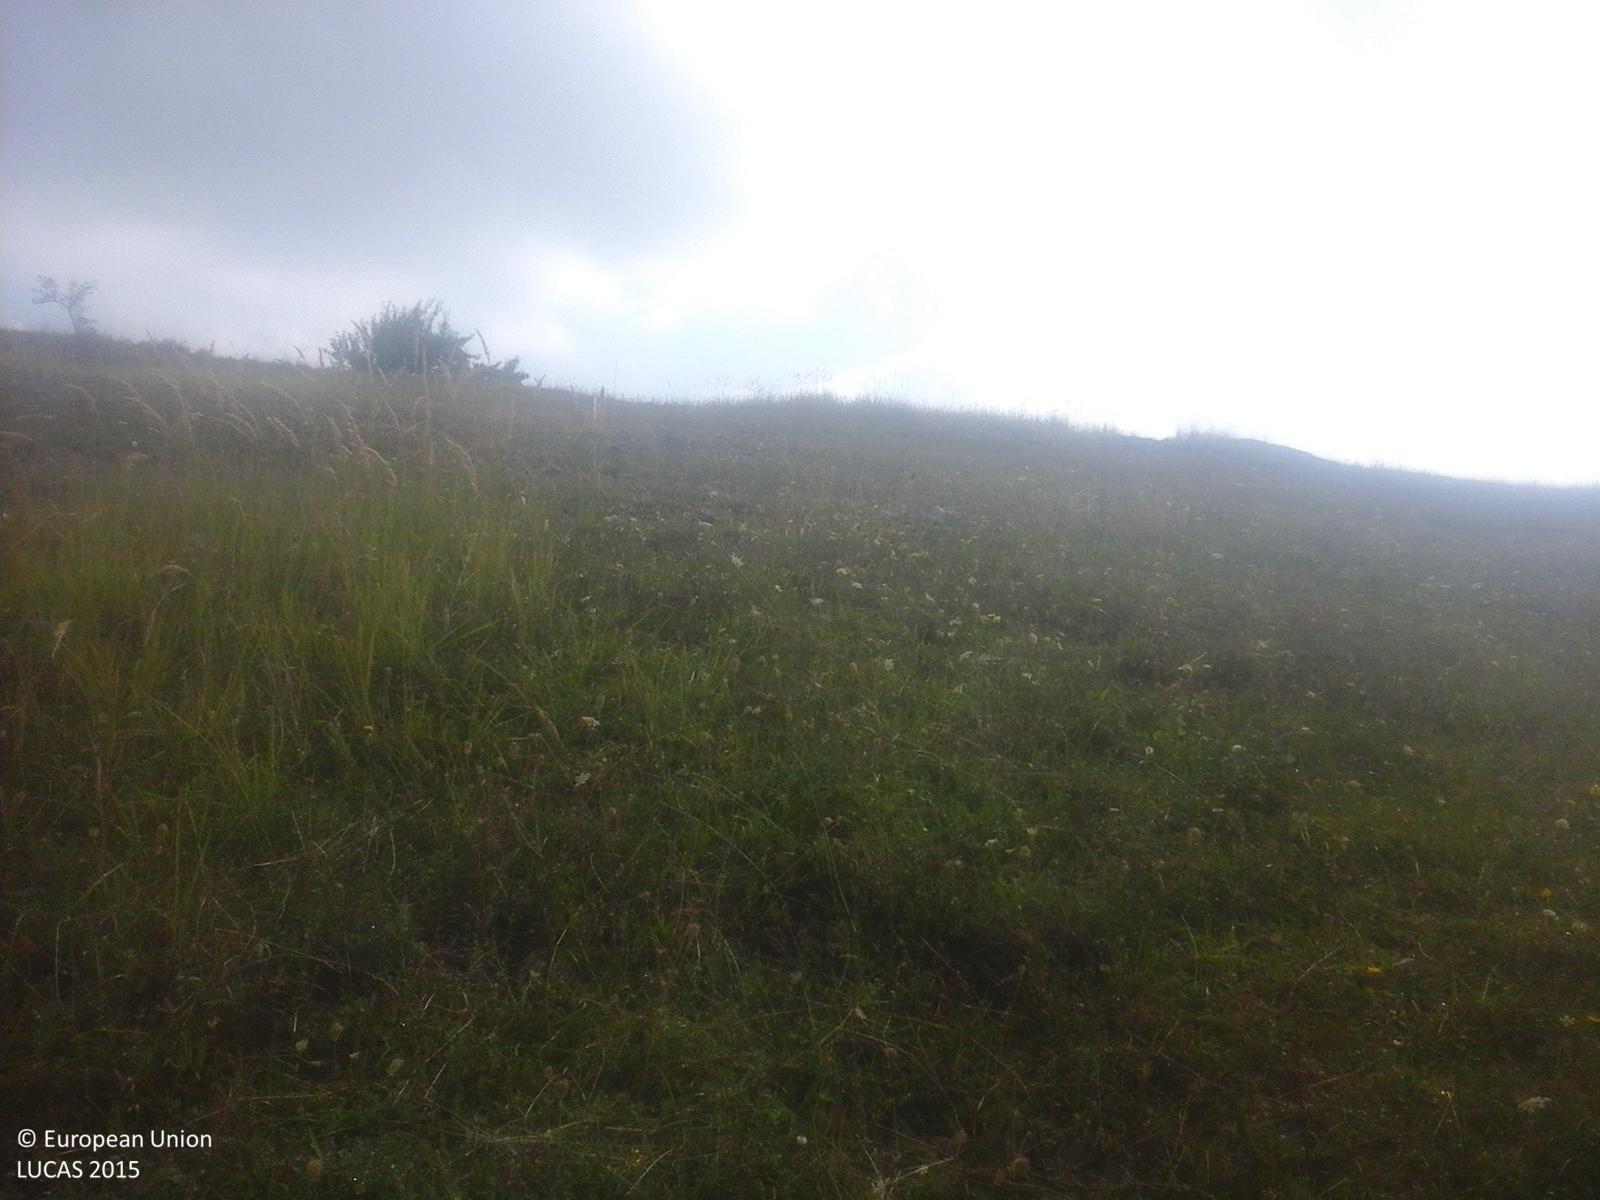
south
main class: Grassland
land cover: Grassland without tree/shrub cover
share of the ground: > 75 %
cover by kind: herbaceous plants 100 %
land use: Agriculture (excluding fallow land and kitchen gardens)
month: September
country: RO
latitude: 46.8476
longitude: 22.3921
